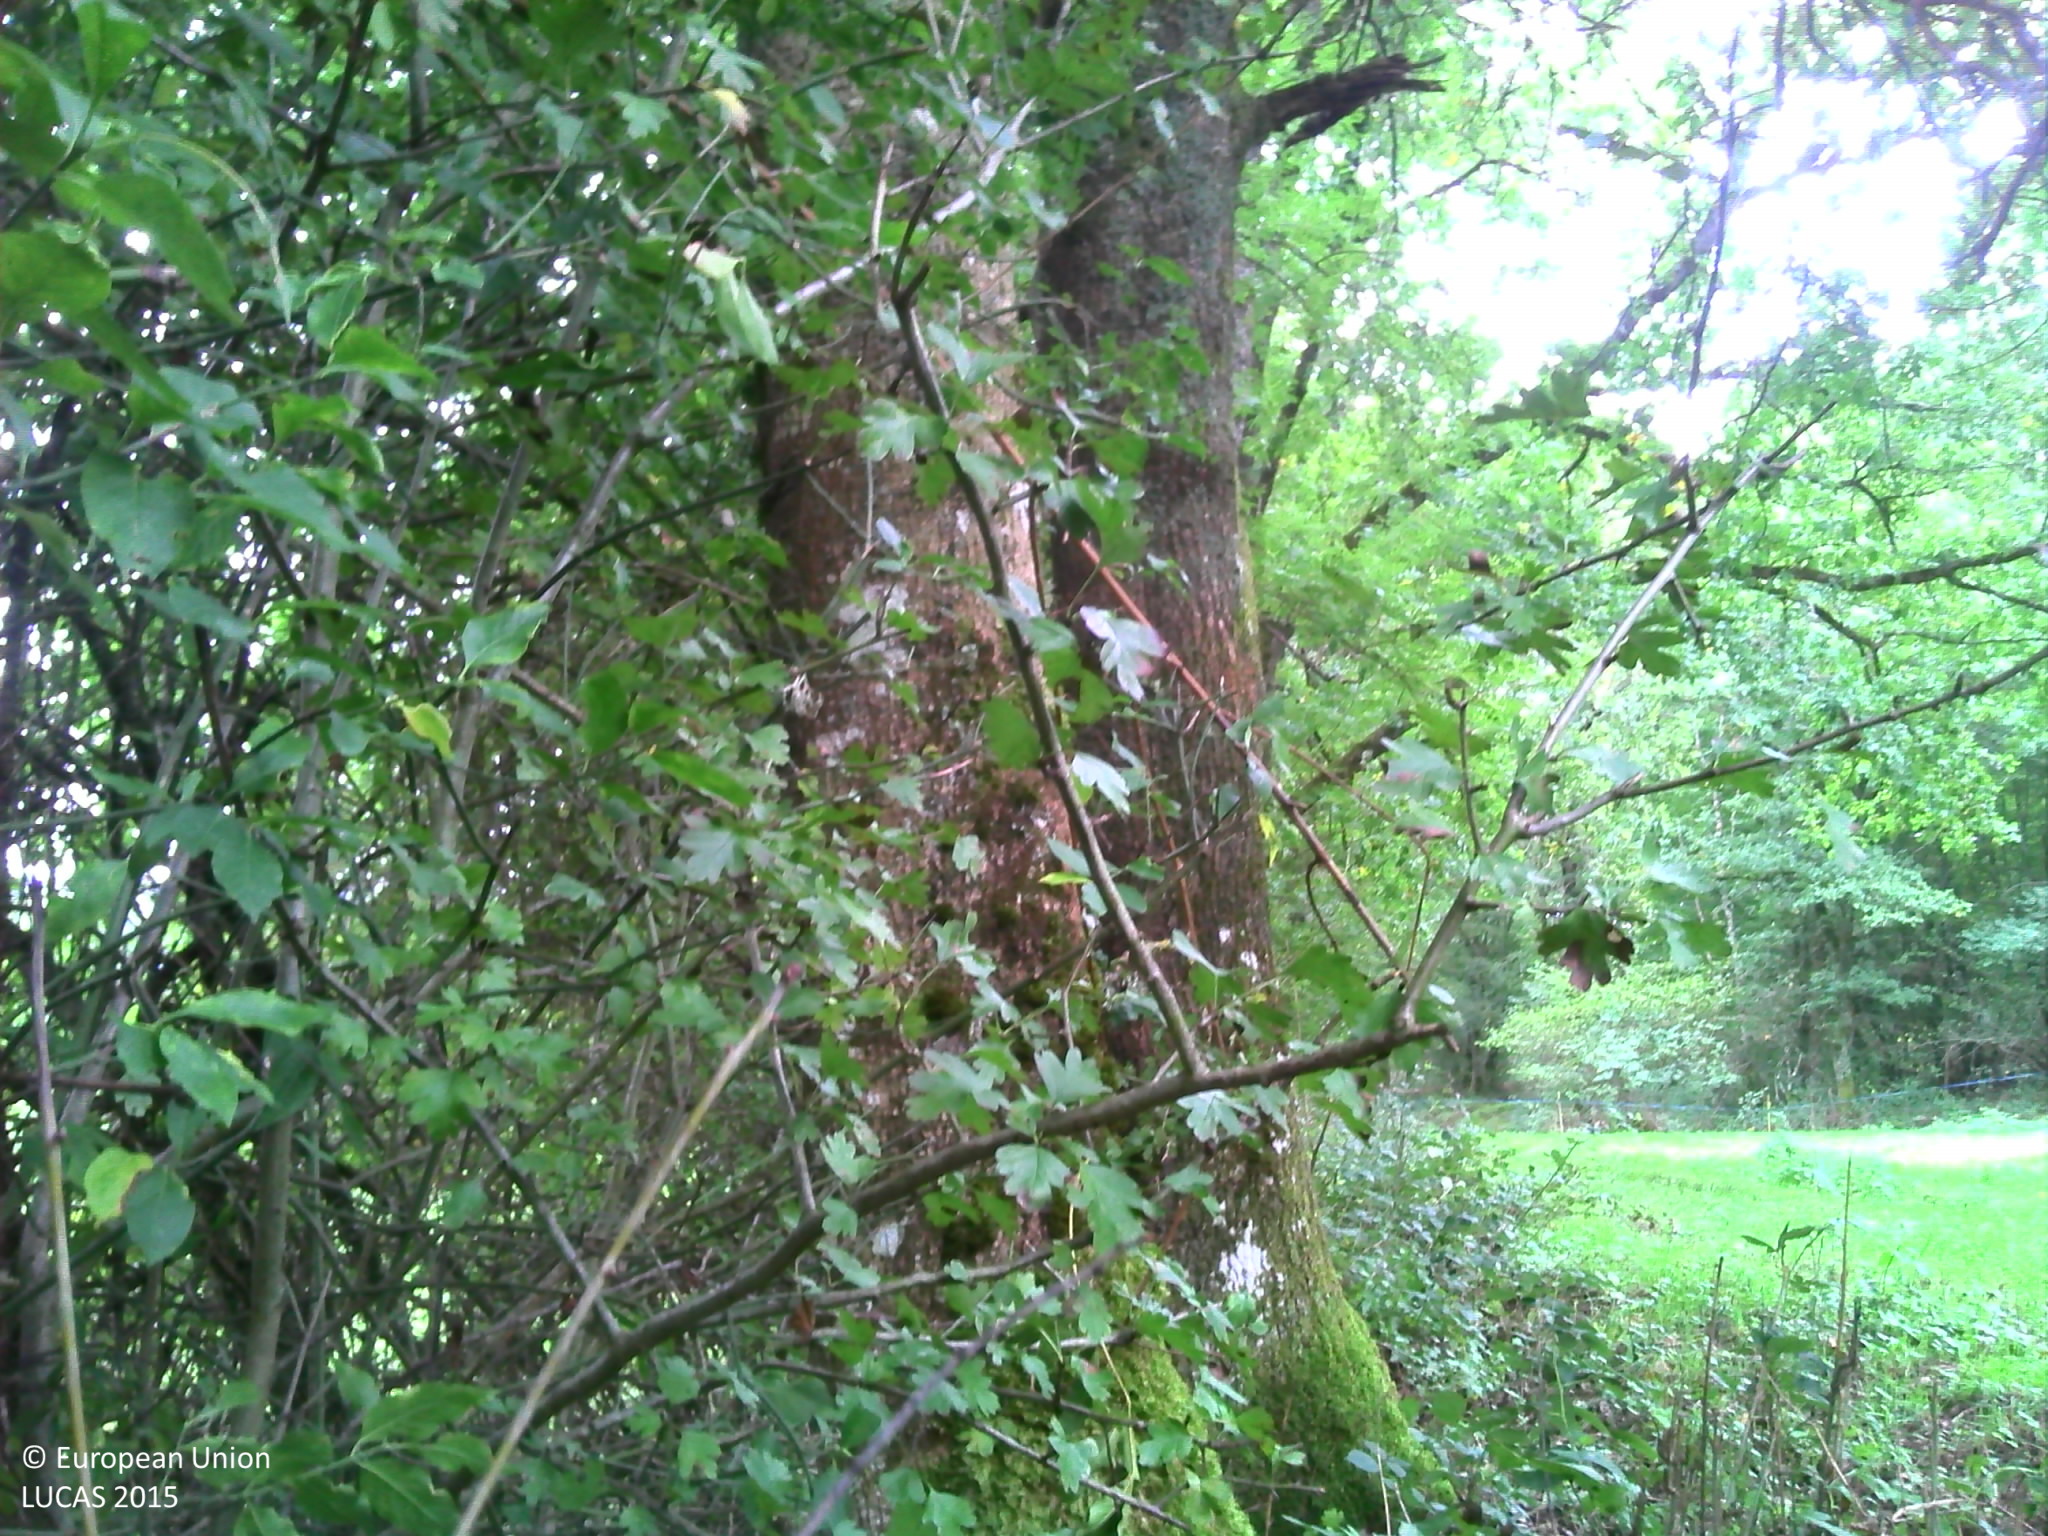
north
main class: Woodland
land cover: Broadleaved woodland
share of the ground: > 75 %
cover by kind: broadleaved forest trees 100 %
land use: Semi-natural and natural areas not in use
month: September
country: FR
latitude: 47.0876
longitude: 4.3750
